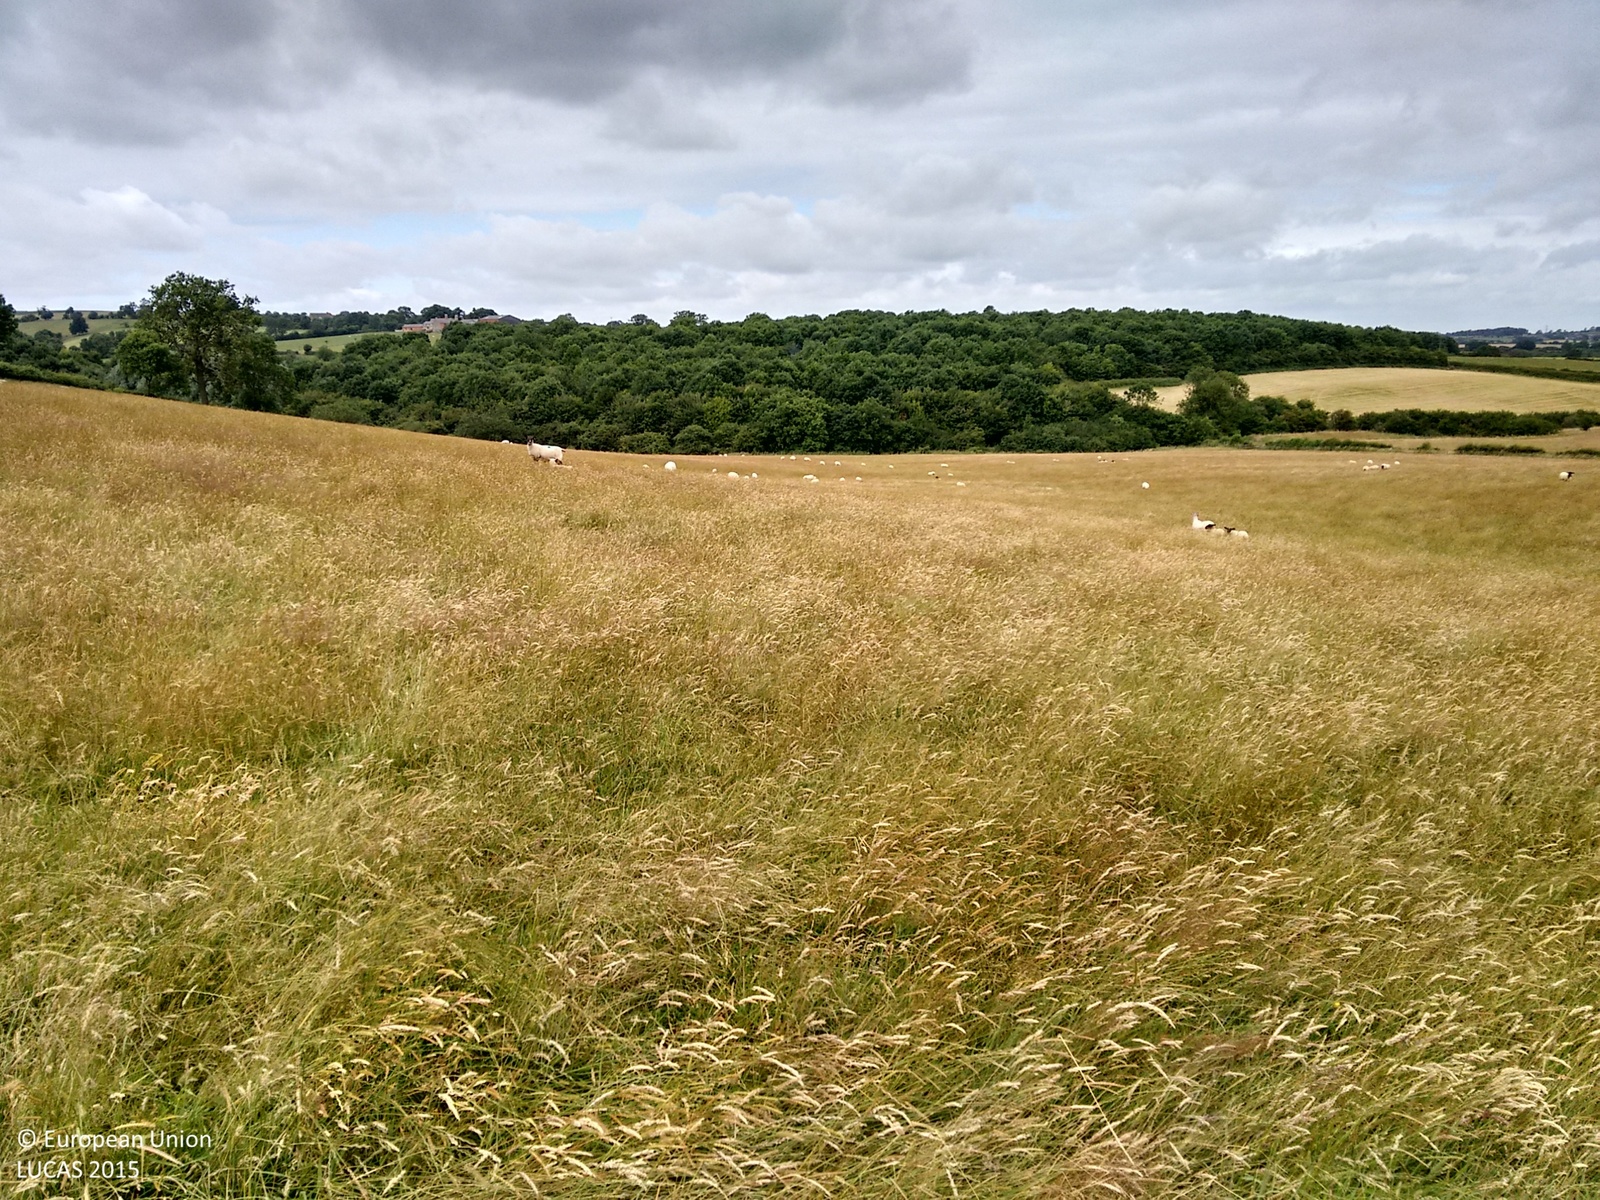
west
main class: Grassland
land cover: Grassland without tree/shrub cover
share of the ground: > 75 %
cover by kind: herbaceous plants 100 %
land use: Agriculture (excluding fallow land and kitchen gardens)
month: July
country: GB
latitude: 52.6562
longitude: -0.8787
